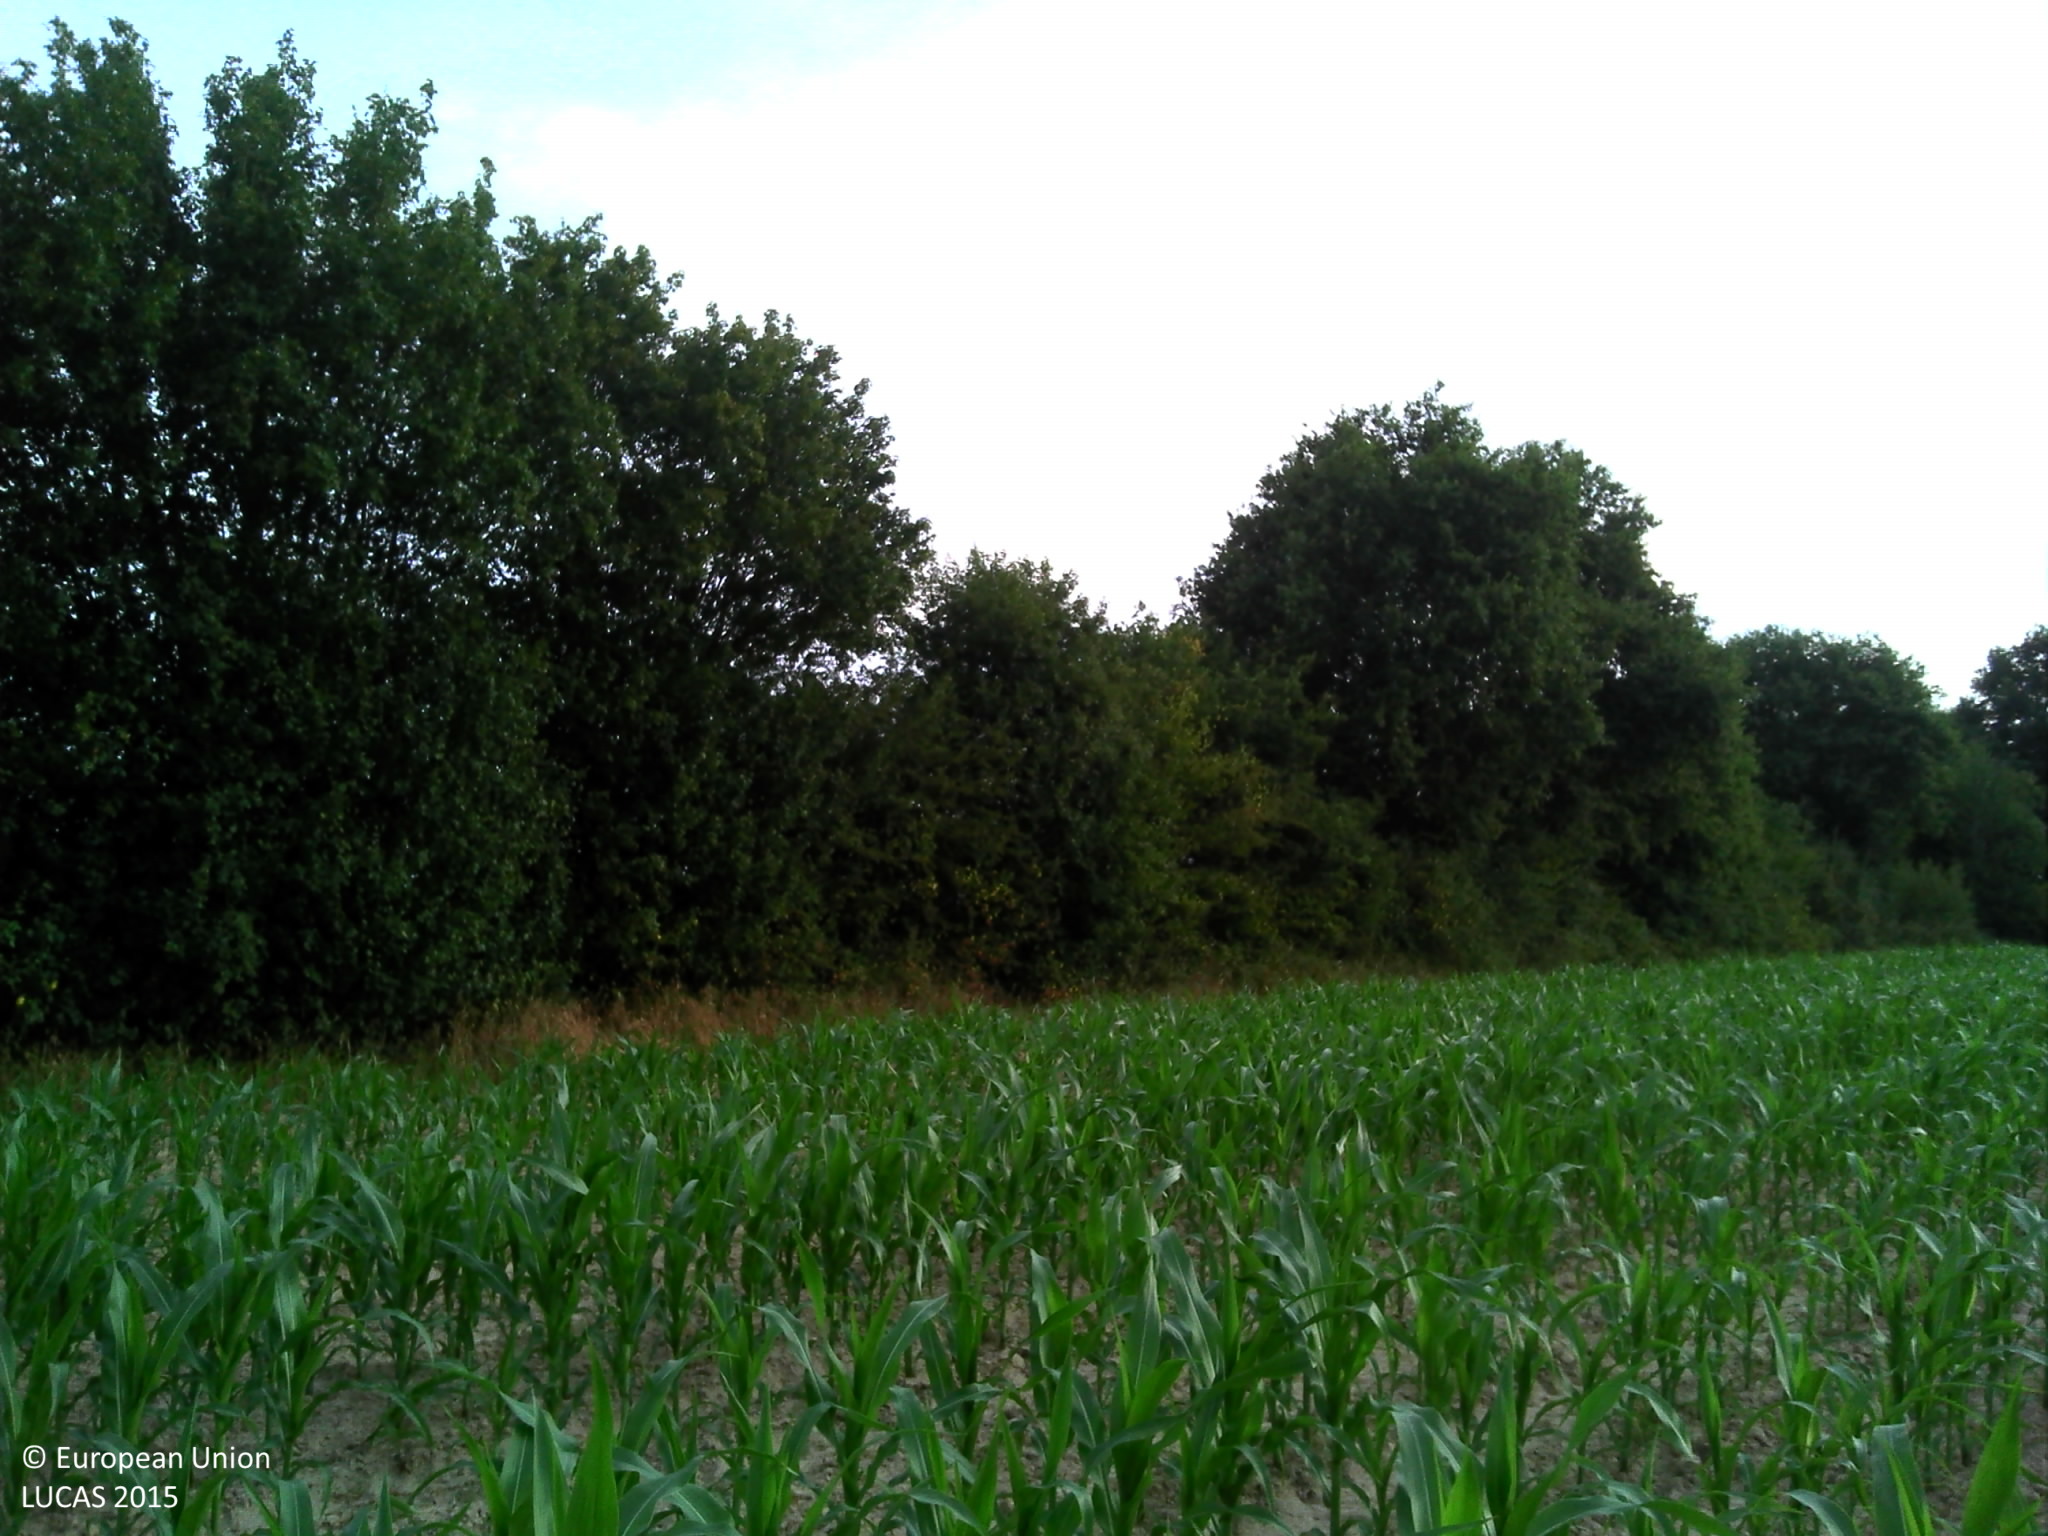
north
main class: Cropland
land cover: Maize
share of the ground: 25 - 50 %
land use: Agriculture (excluding fallow land and kitchen gardens)
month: July
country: FR
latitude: 47.7885
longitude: 0.4329
